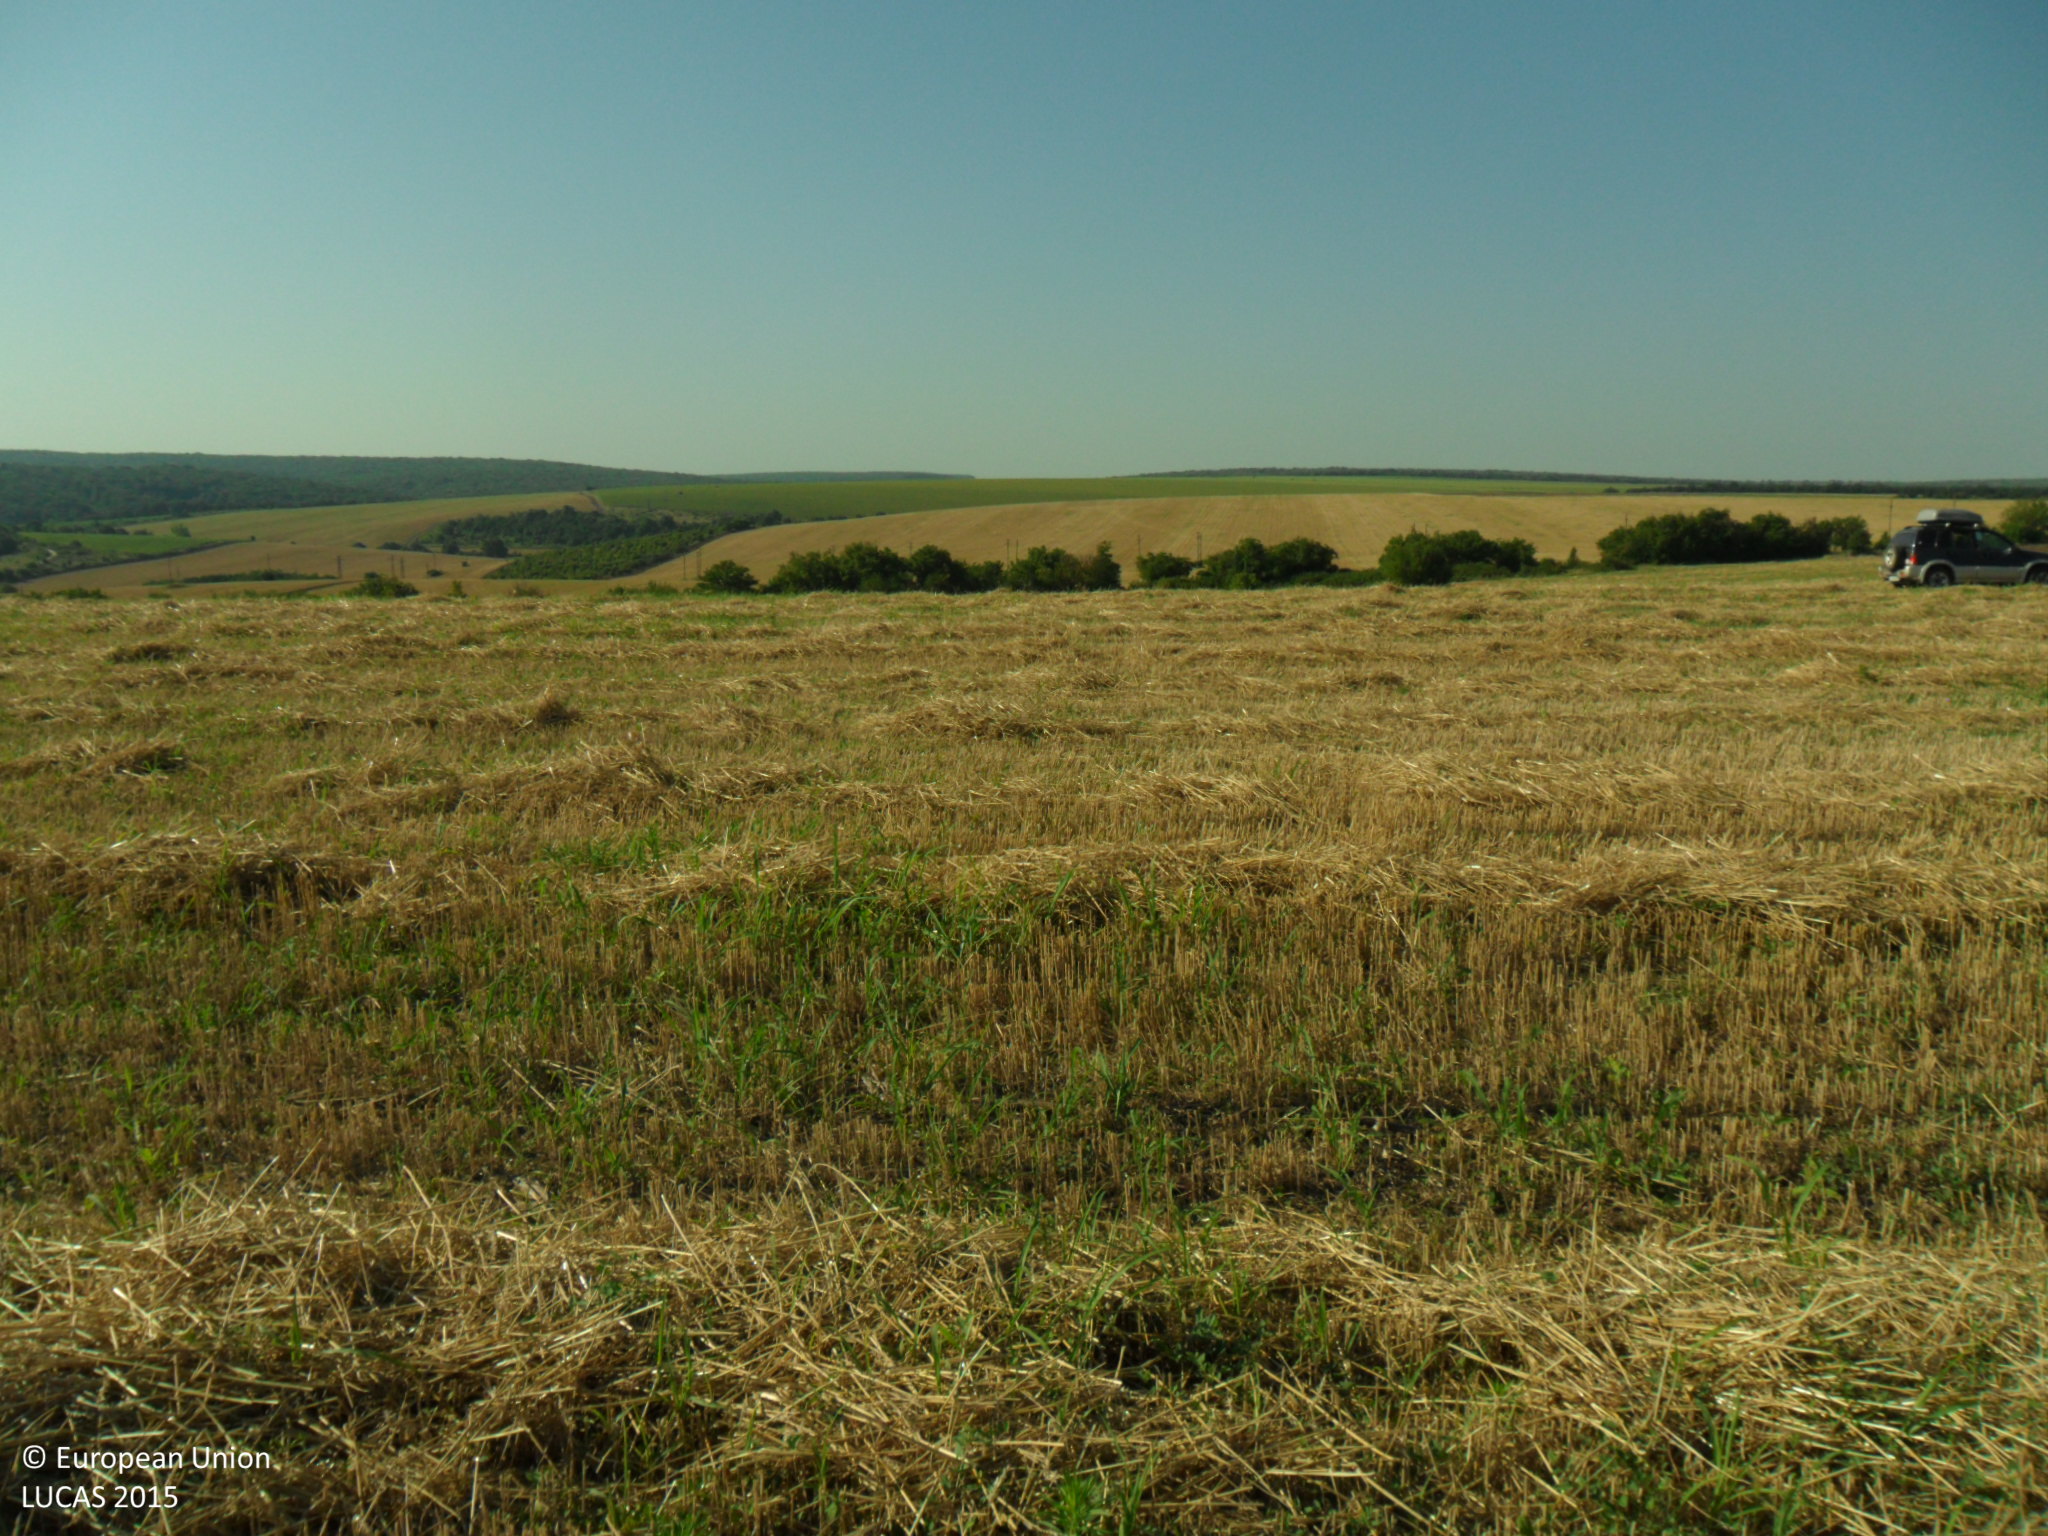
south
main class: Cropland
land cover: Common wheat
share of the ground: 10 - 25 %
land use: Agriculture (excluding fallow land and kitchen gardens)
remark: Harvested field
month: July
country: BG
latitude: 43.8182
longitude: 26.3291
